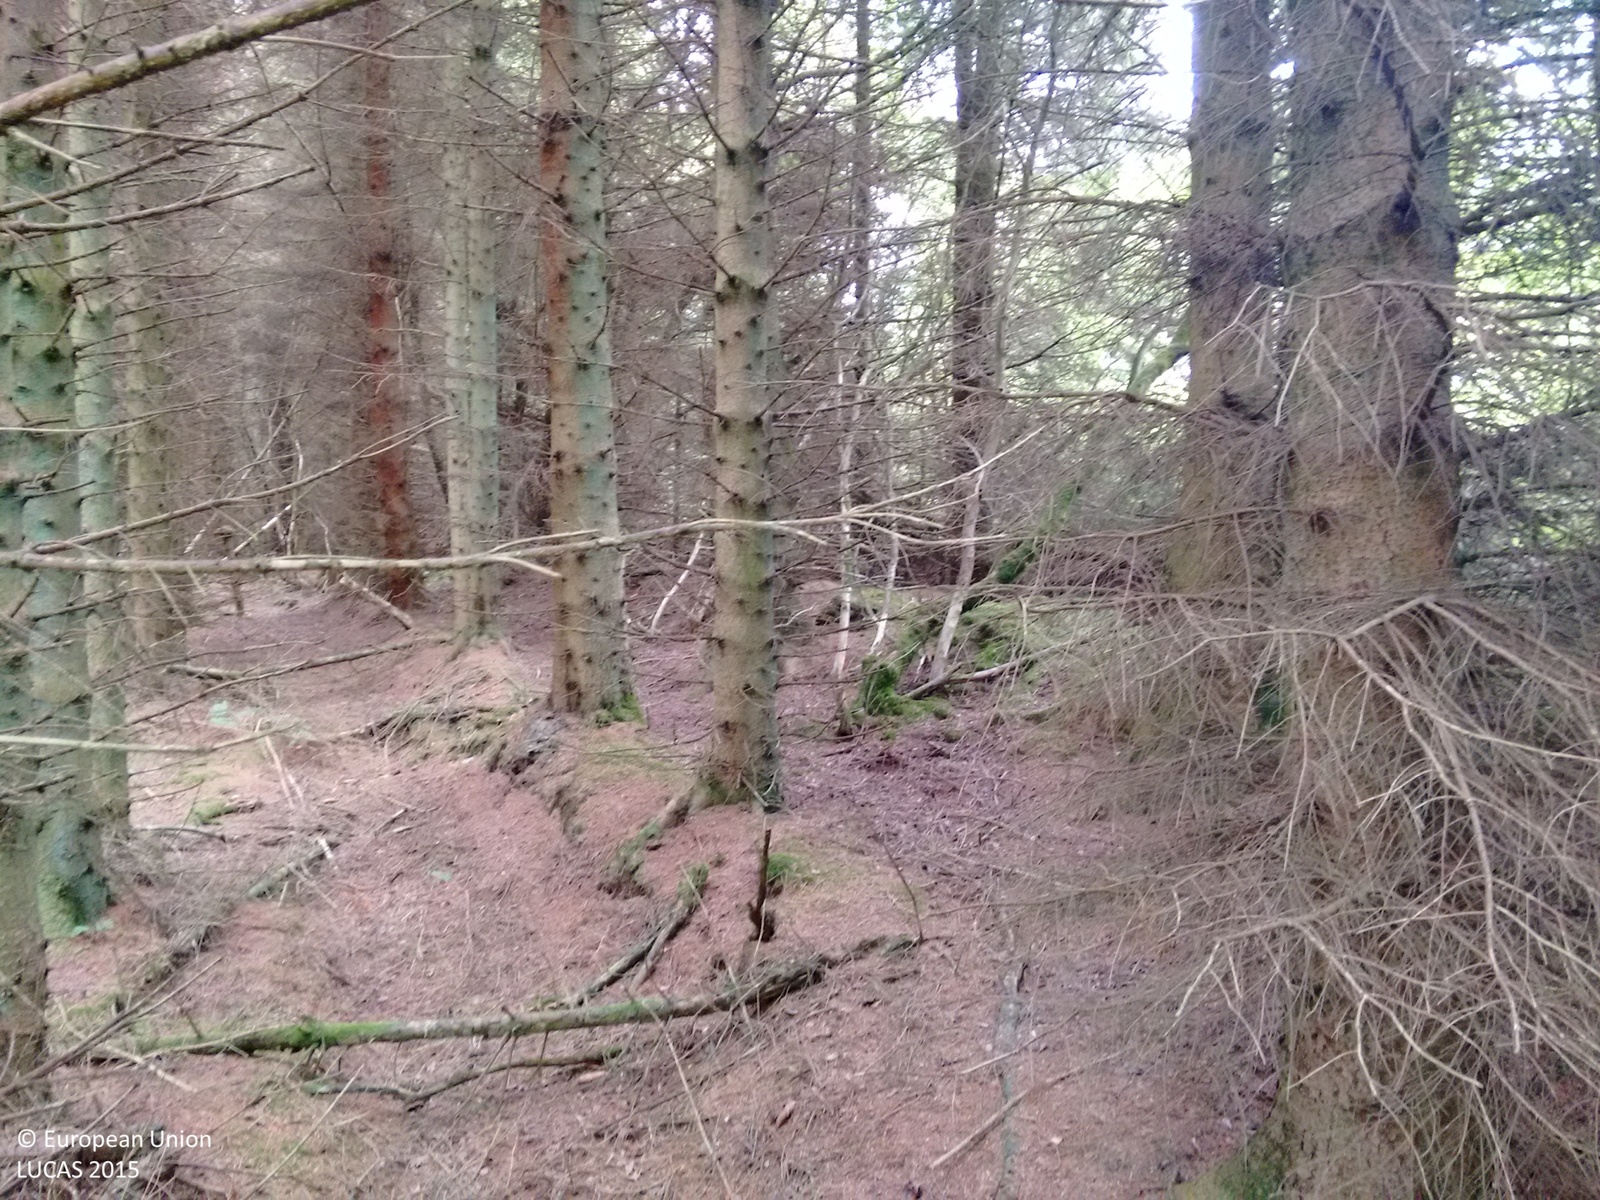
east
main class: Woodland
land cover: Spruce dominated mixed woodland
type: exotic forest
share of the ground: > 75 %
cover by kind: coniferous forest trees 75 %, broadleaved forest trees 25 %
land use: Forestry
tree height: > 5 m
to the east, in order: Spruce dominated mixed woodland; Tracks; Spruce dominated mixed woodland; Fences; Grassland without tree/shrub cover
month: August
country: GB
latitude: 53.0435
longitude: -3.4930
